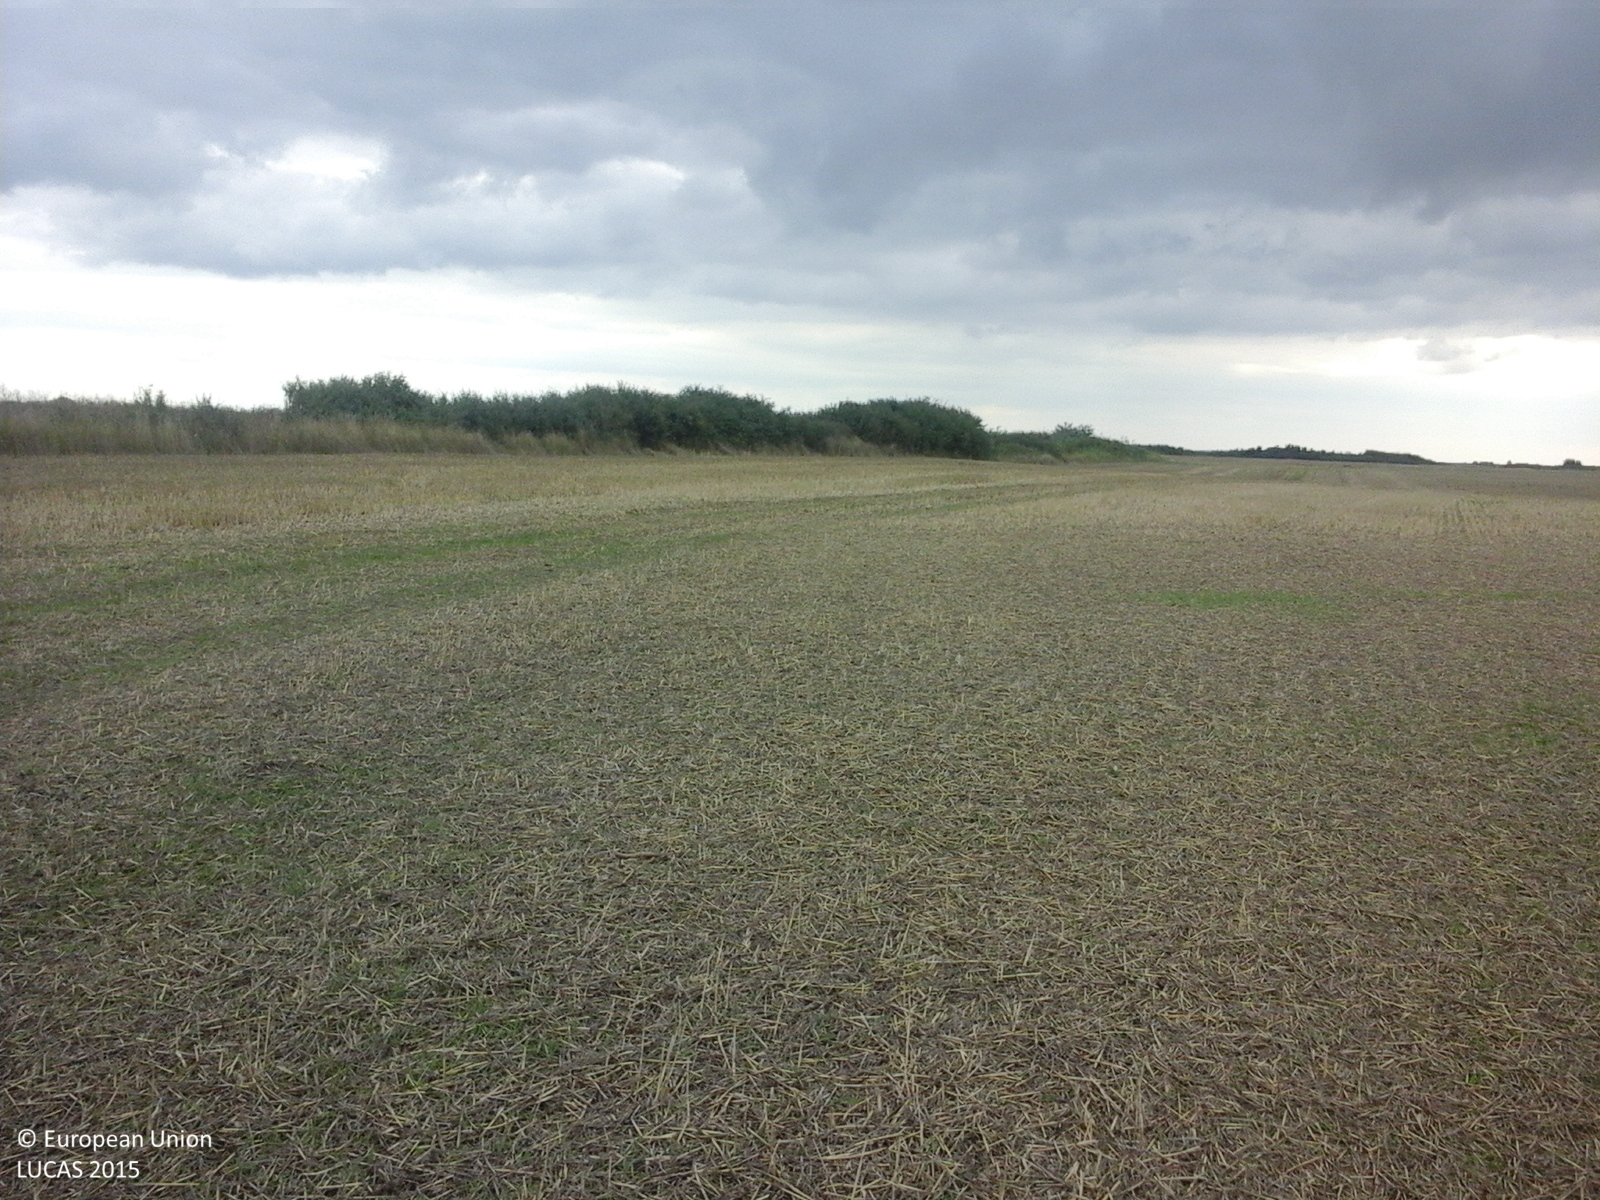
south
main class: Cropland
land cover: Common wheat
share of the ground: 25 - 50 %
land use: Agriculture (excluding fallow land and kitchen gardens)
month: August
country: RO
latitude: 45.4076
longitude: 21.1047
